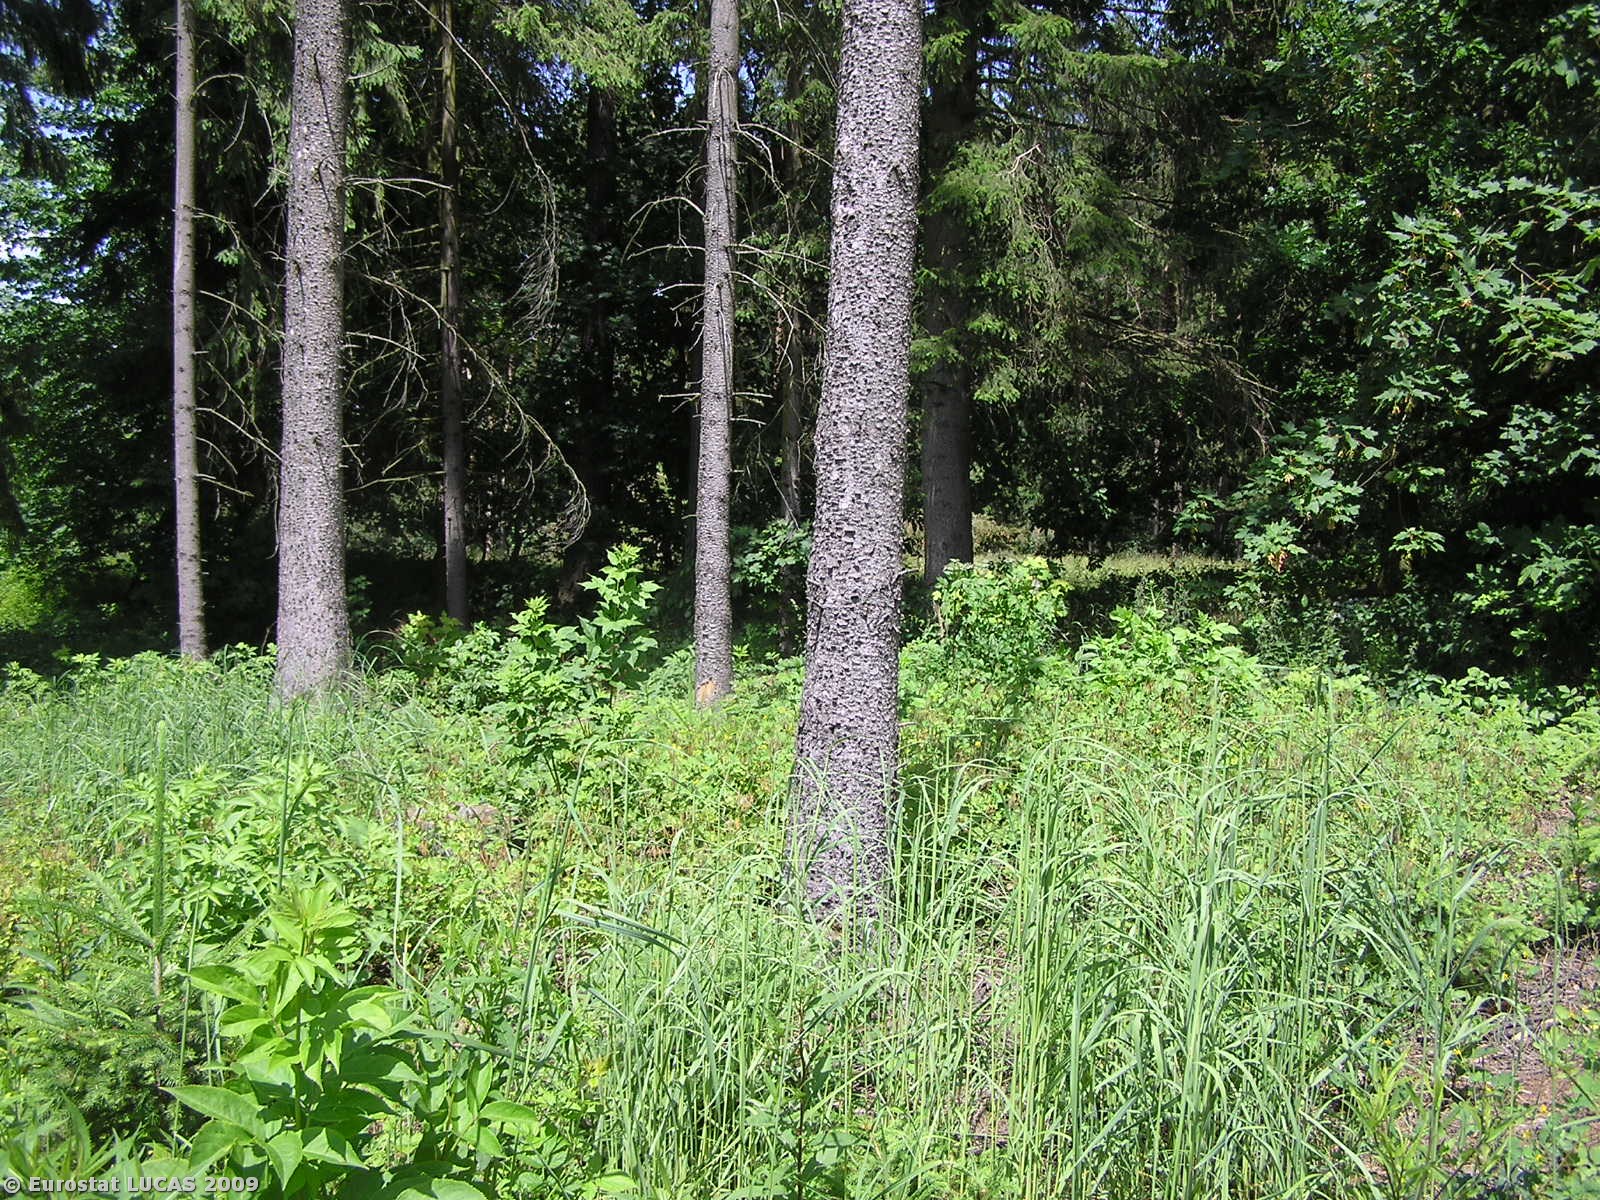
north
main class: Woodland
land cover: Coniferous woodland
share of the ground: 25 - 50 %
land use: Forestry
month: June
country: CZ
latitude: 49.4806
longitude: 14.9851
